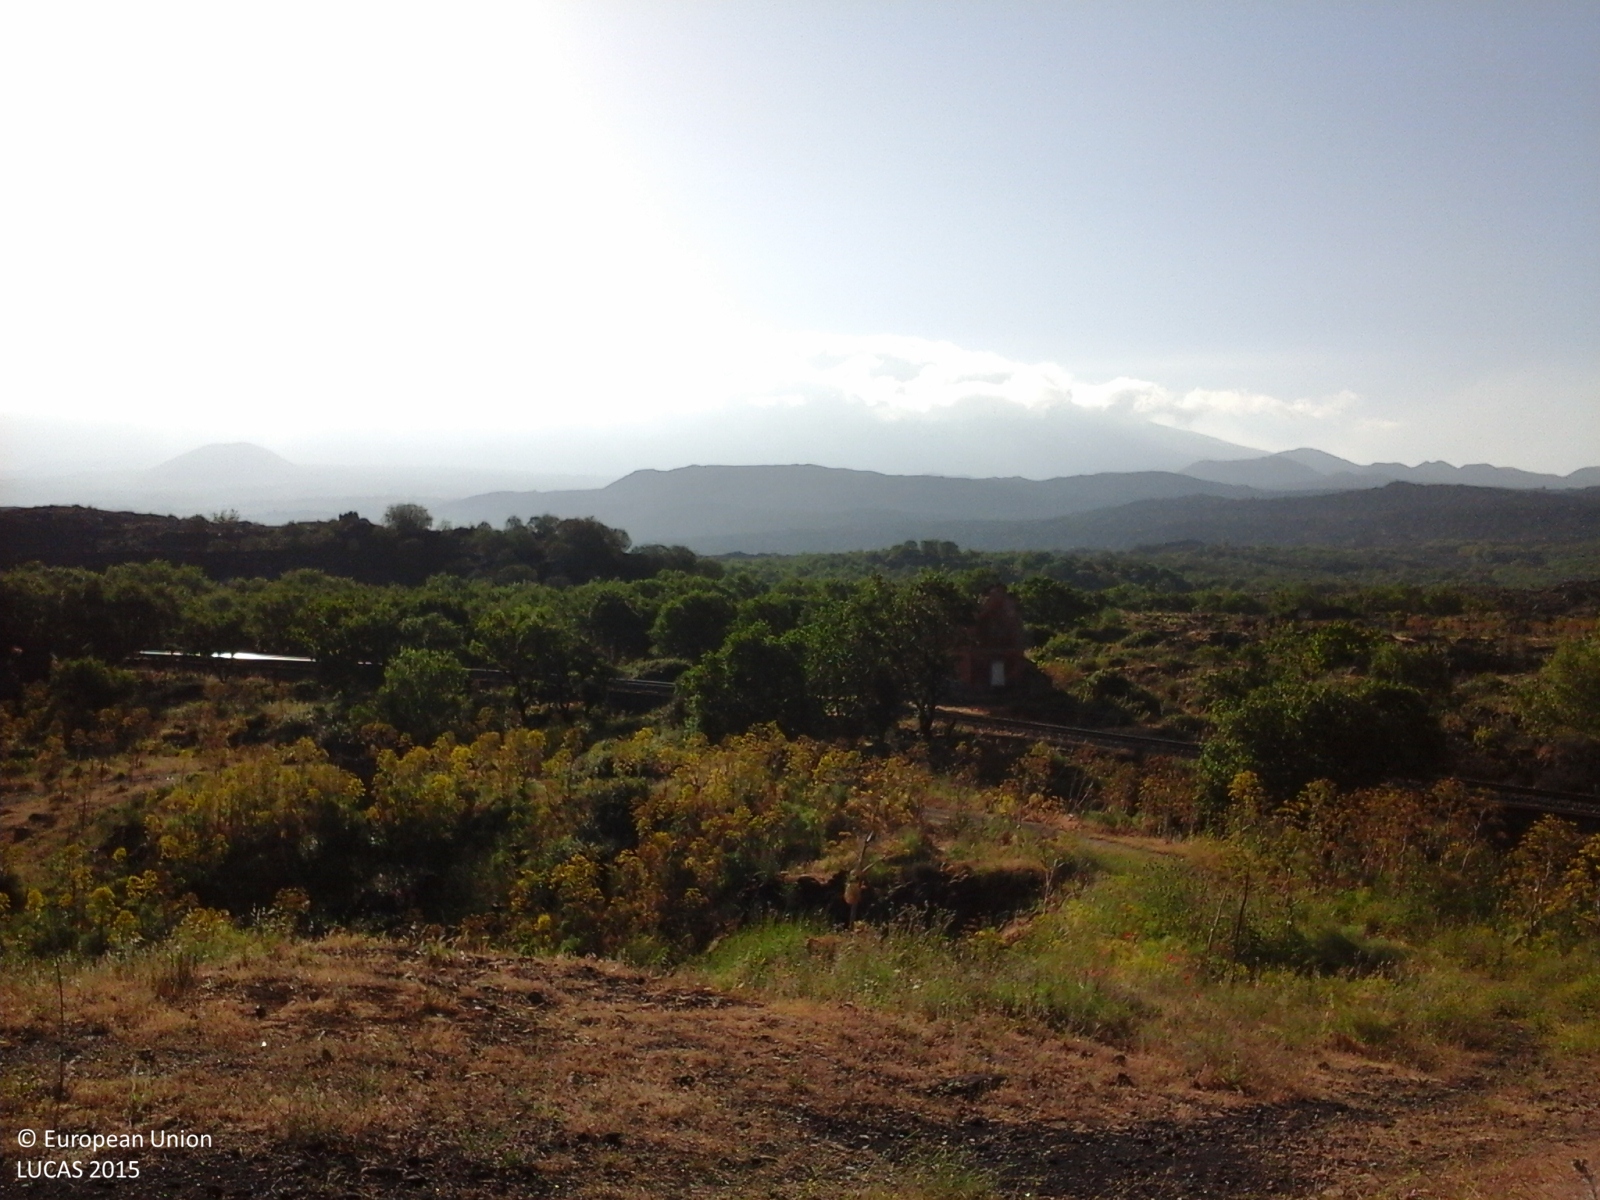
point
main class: Woodland
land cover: Broadleaved woodland
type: thermophilous deciduous forest
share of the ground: > 75 %
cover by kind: broadleaved forest trees 100 %
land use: Forestry
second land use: Amenities, museums, leisure
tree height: > 5 m
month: May
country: IT
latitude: 37.7869
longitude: 14.8604
